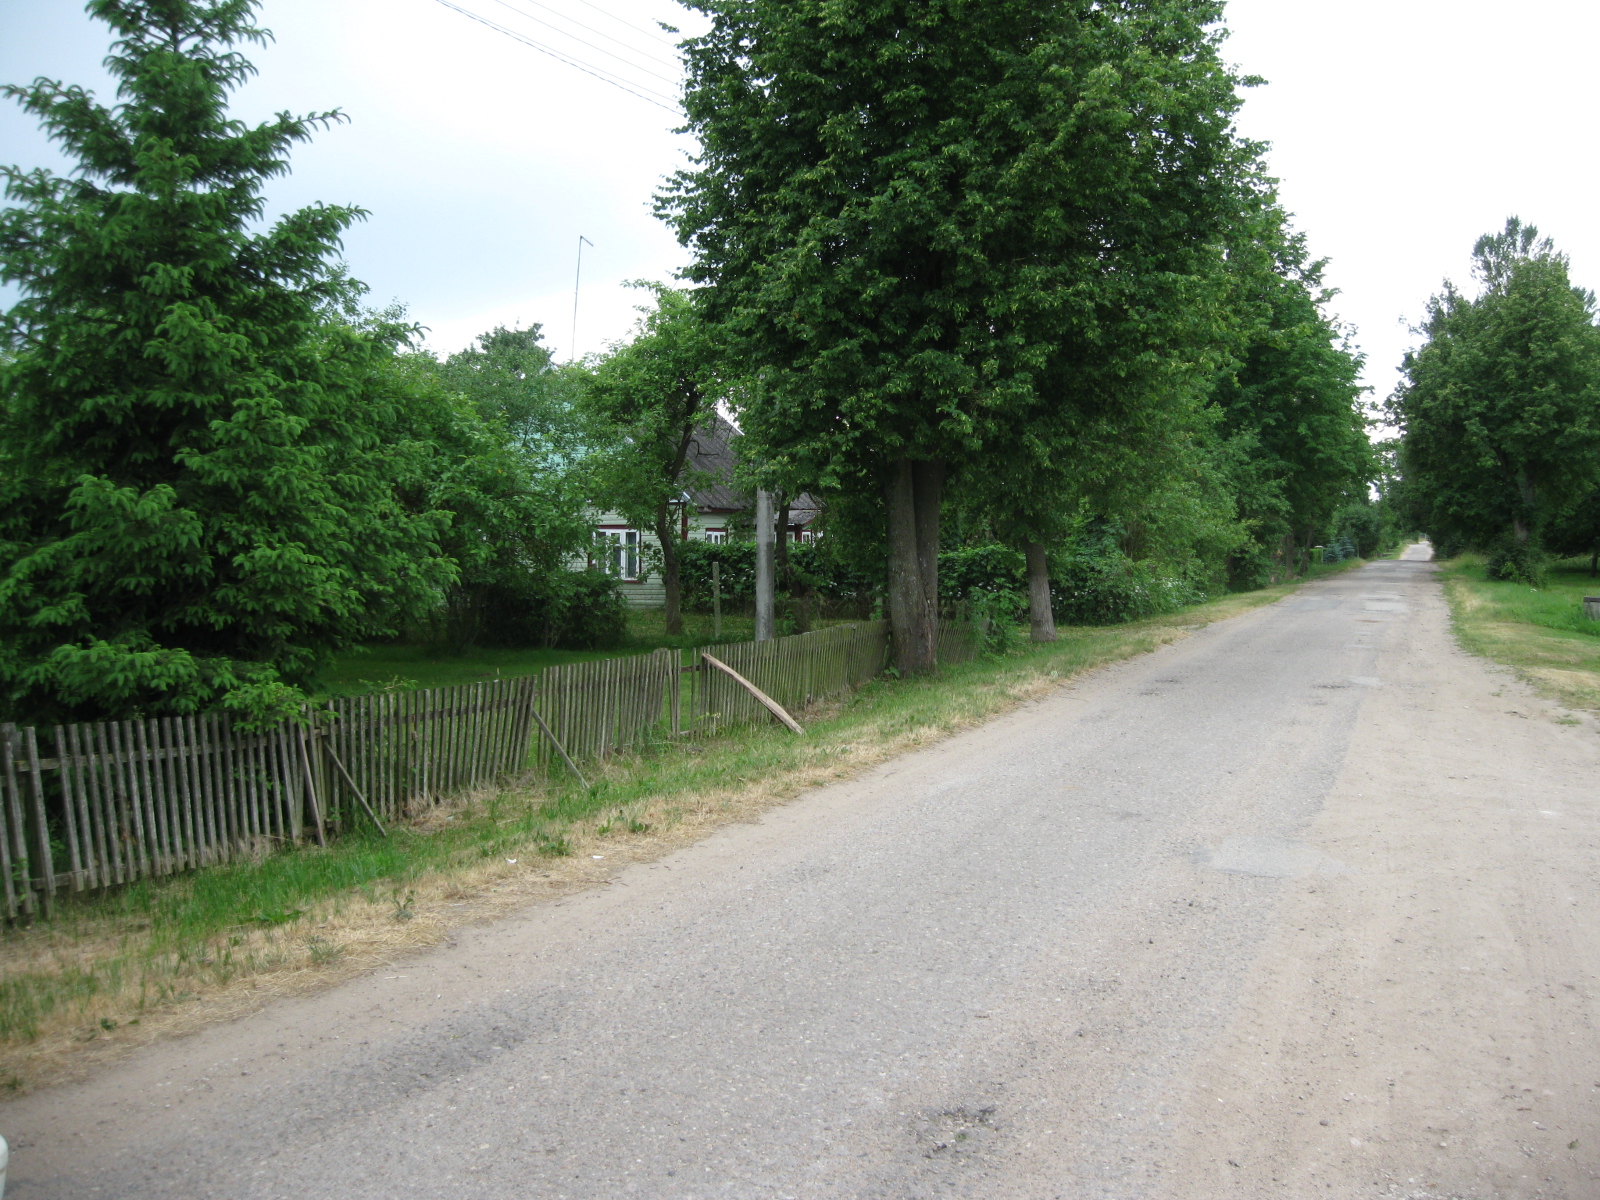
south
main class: Grassland
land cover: Grassland with sparse tree/shrub cover
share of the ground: > 75 %
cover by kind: herbaceous plants 90 %, broadleaved forest trees 5 %, shrubs 5 %
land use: Agriculture (excluding fallow land and kitchen gardens)
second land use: Residential
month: June
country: LT
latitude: 55.3265
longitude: 24.1361
